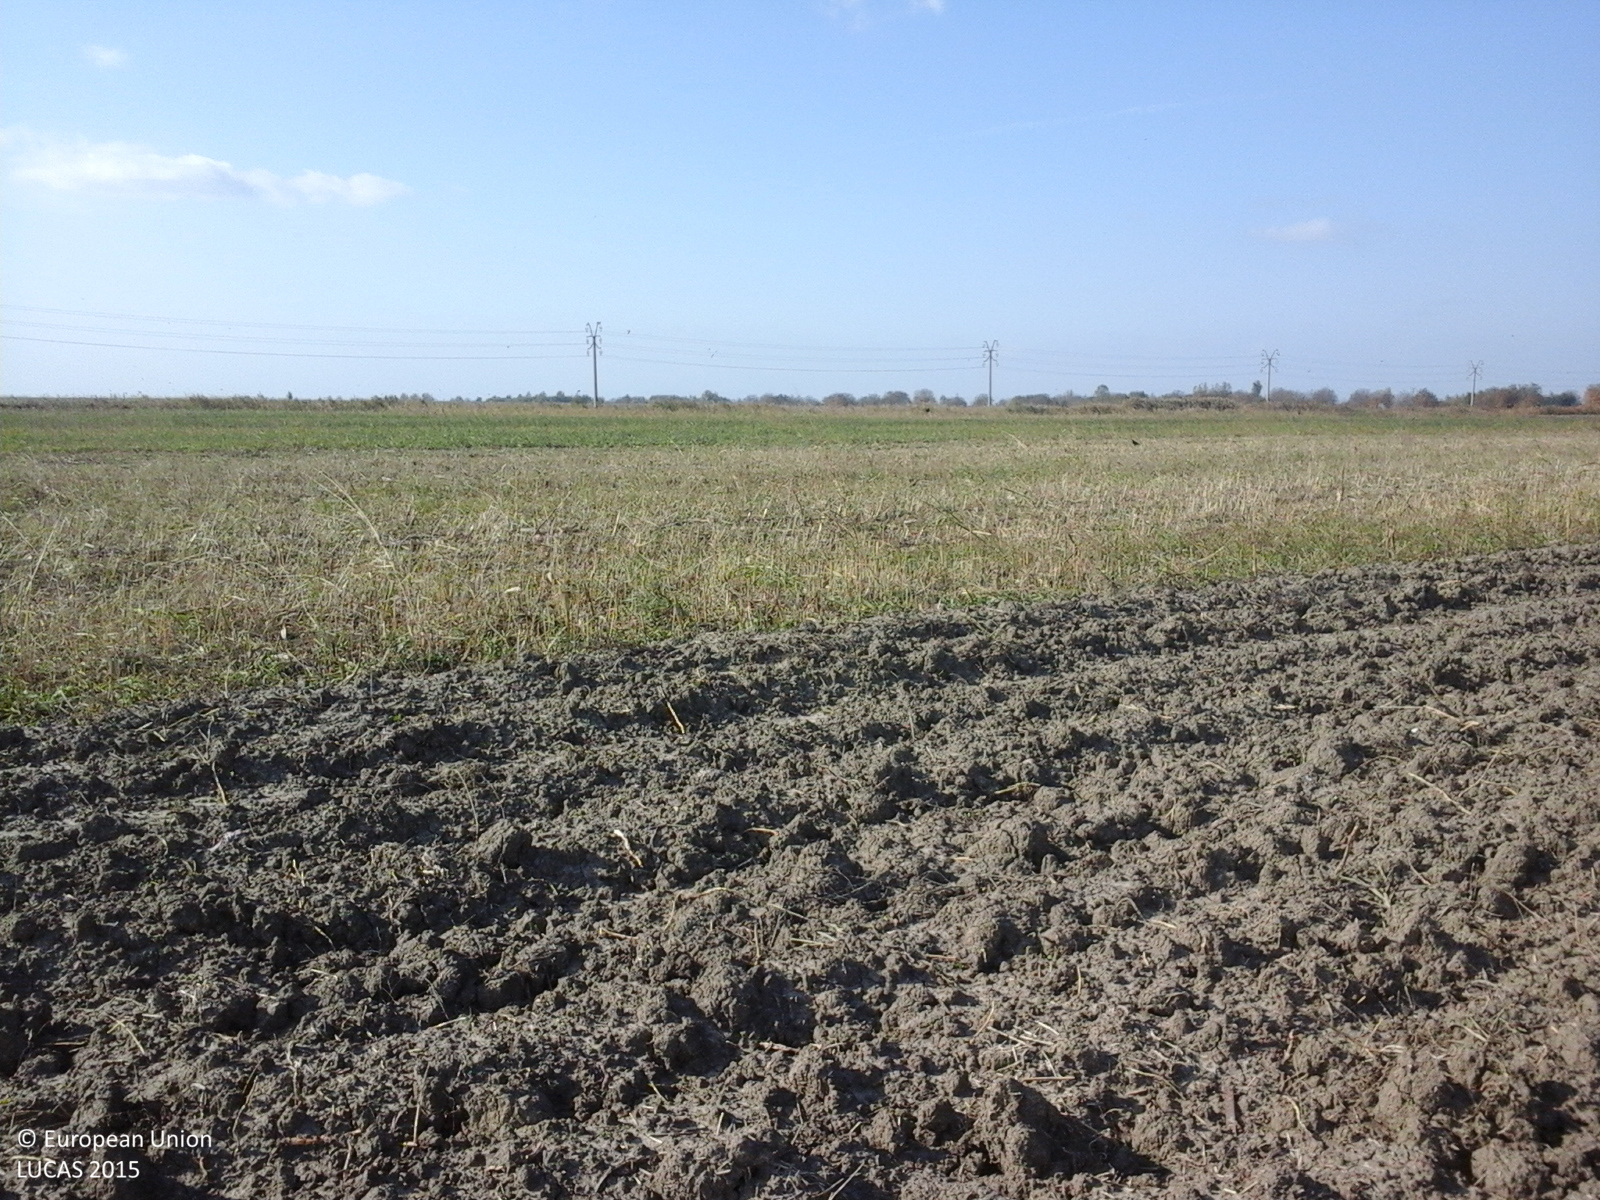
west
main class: Cropland
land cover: Maize
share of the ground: < 10 %
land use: Agriculture (excluding fallow land and kitchen gardens)
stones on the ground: < 10 %
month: October
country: RO
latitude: 45.4934
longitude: 27.4393
